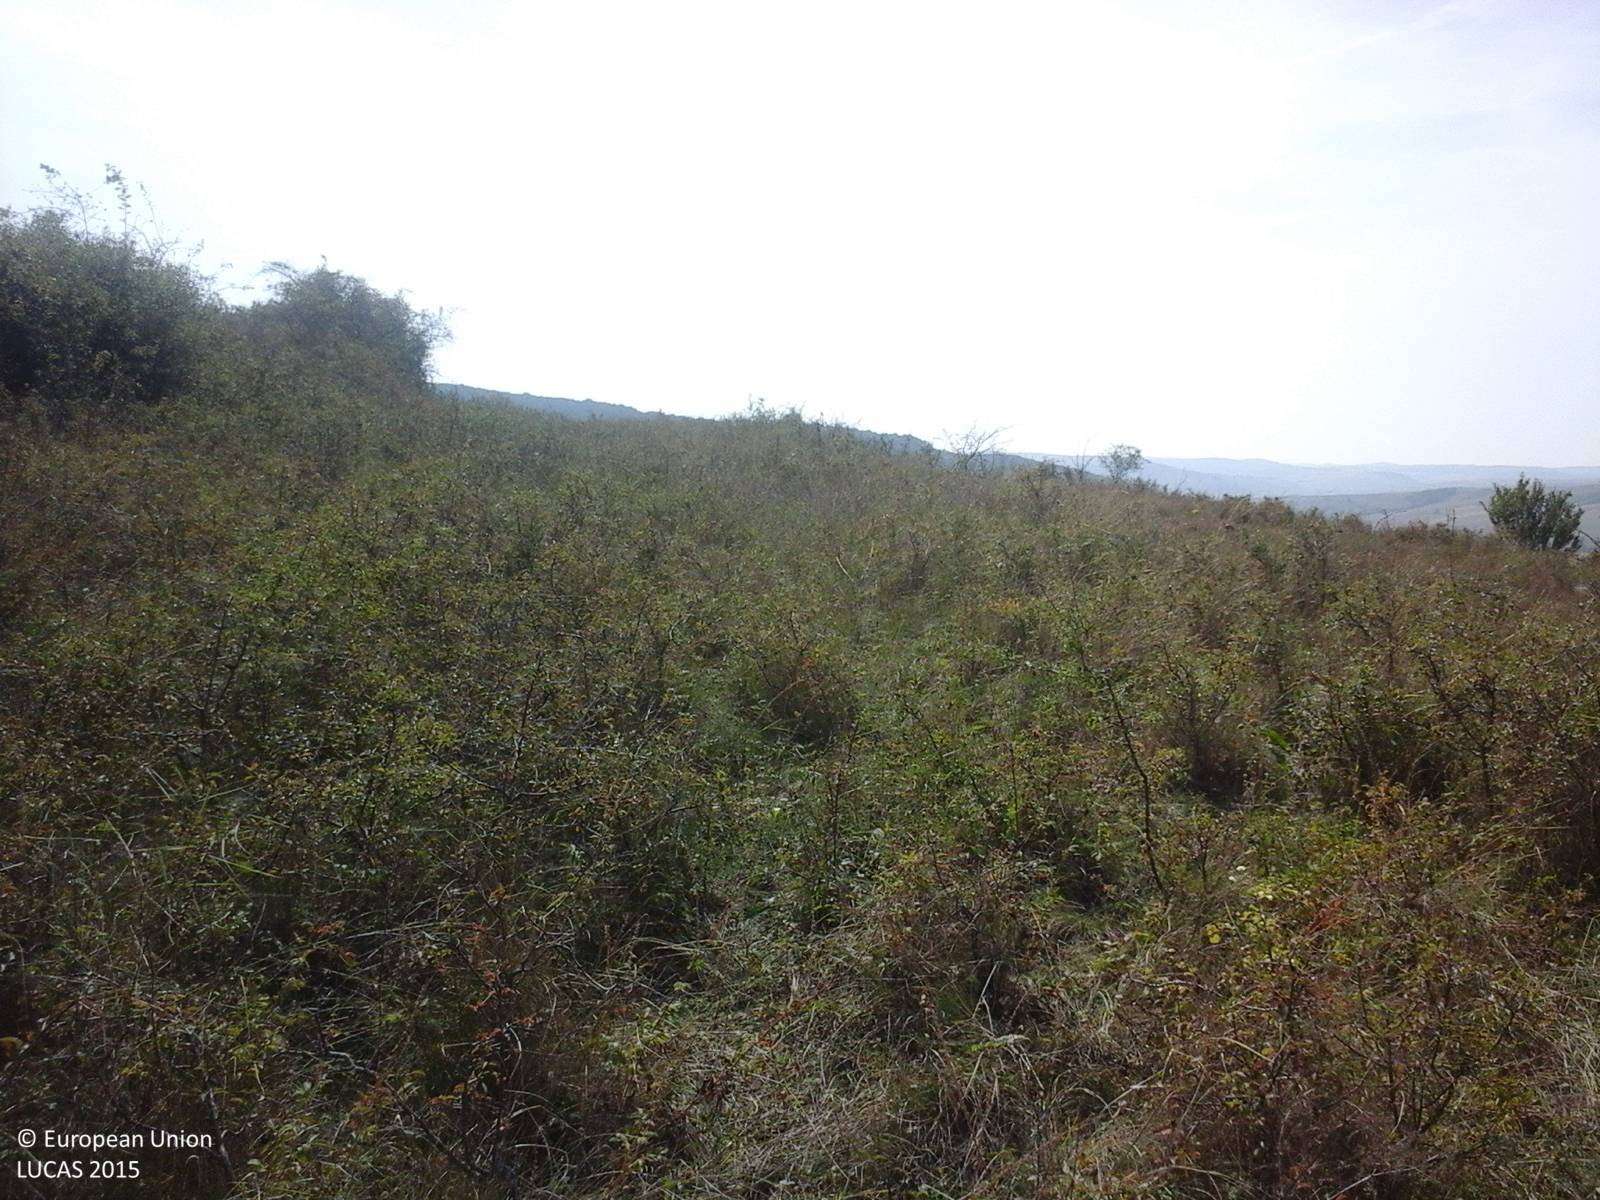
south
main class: Shrubland
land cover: Shrubland with sparse tree cover
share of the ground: > 75 %
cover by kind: herbaceous plants 55 %, shrubs 40 %, broadleaved forest trees 5 %
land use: Fallow land
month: September
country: RO
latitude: 46.8933
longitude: 24.0856
